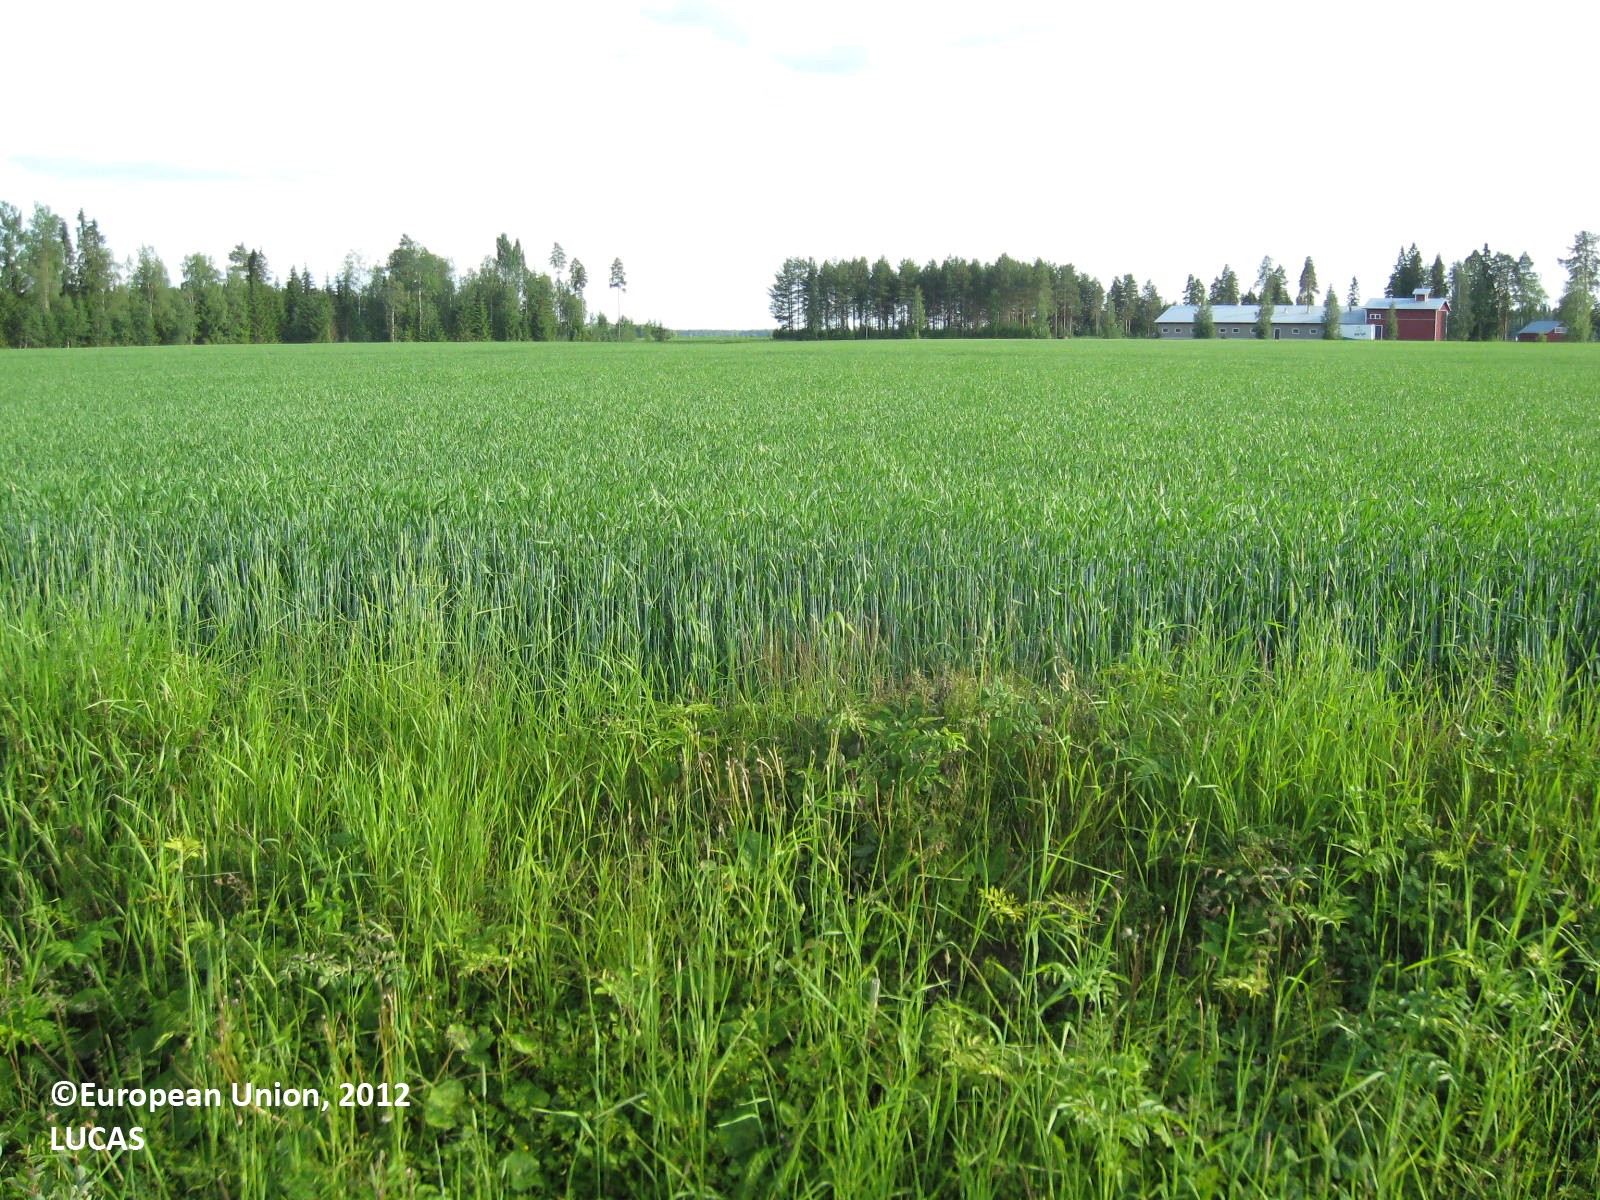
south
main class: Cropland
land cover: Barley
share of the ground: > 75 %
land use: Agriculture (excluding fallow land and kitchen gardens)
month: July
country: FI
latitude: 62.5183
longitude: 21.7198
